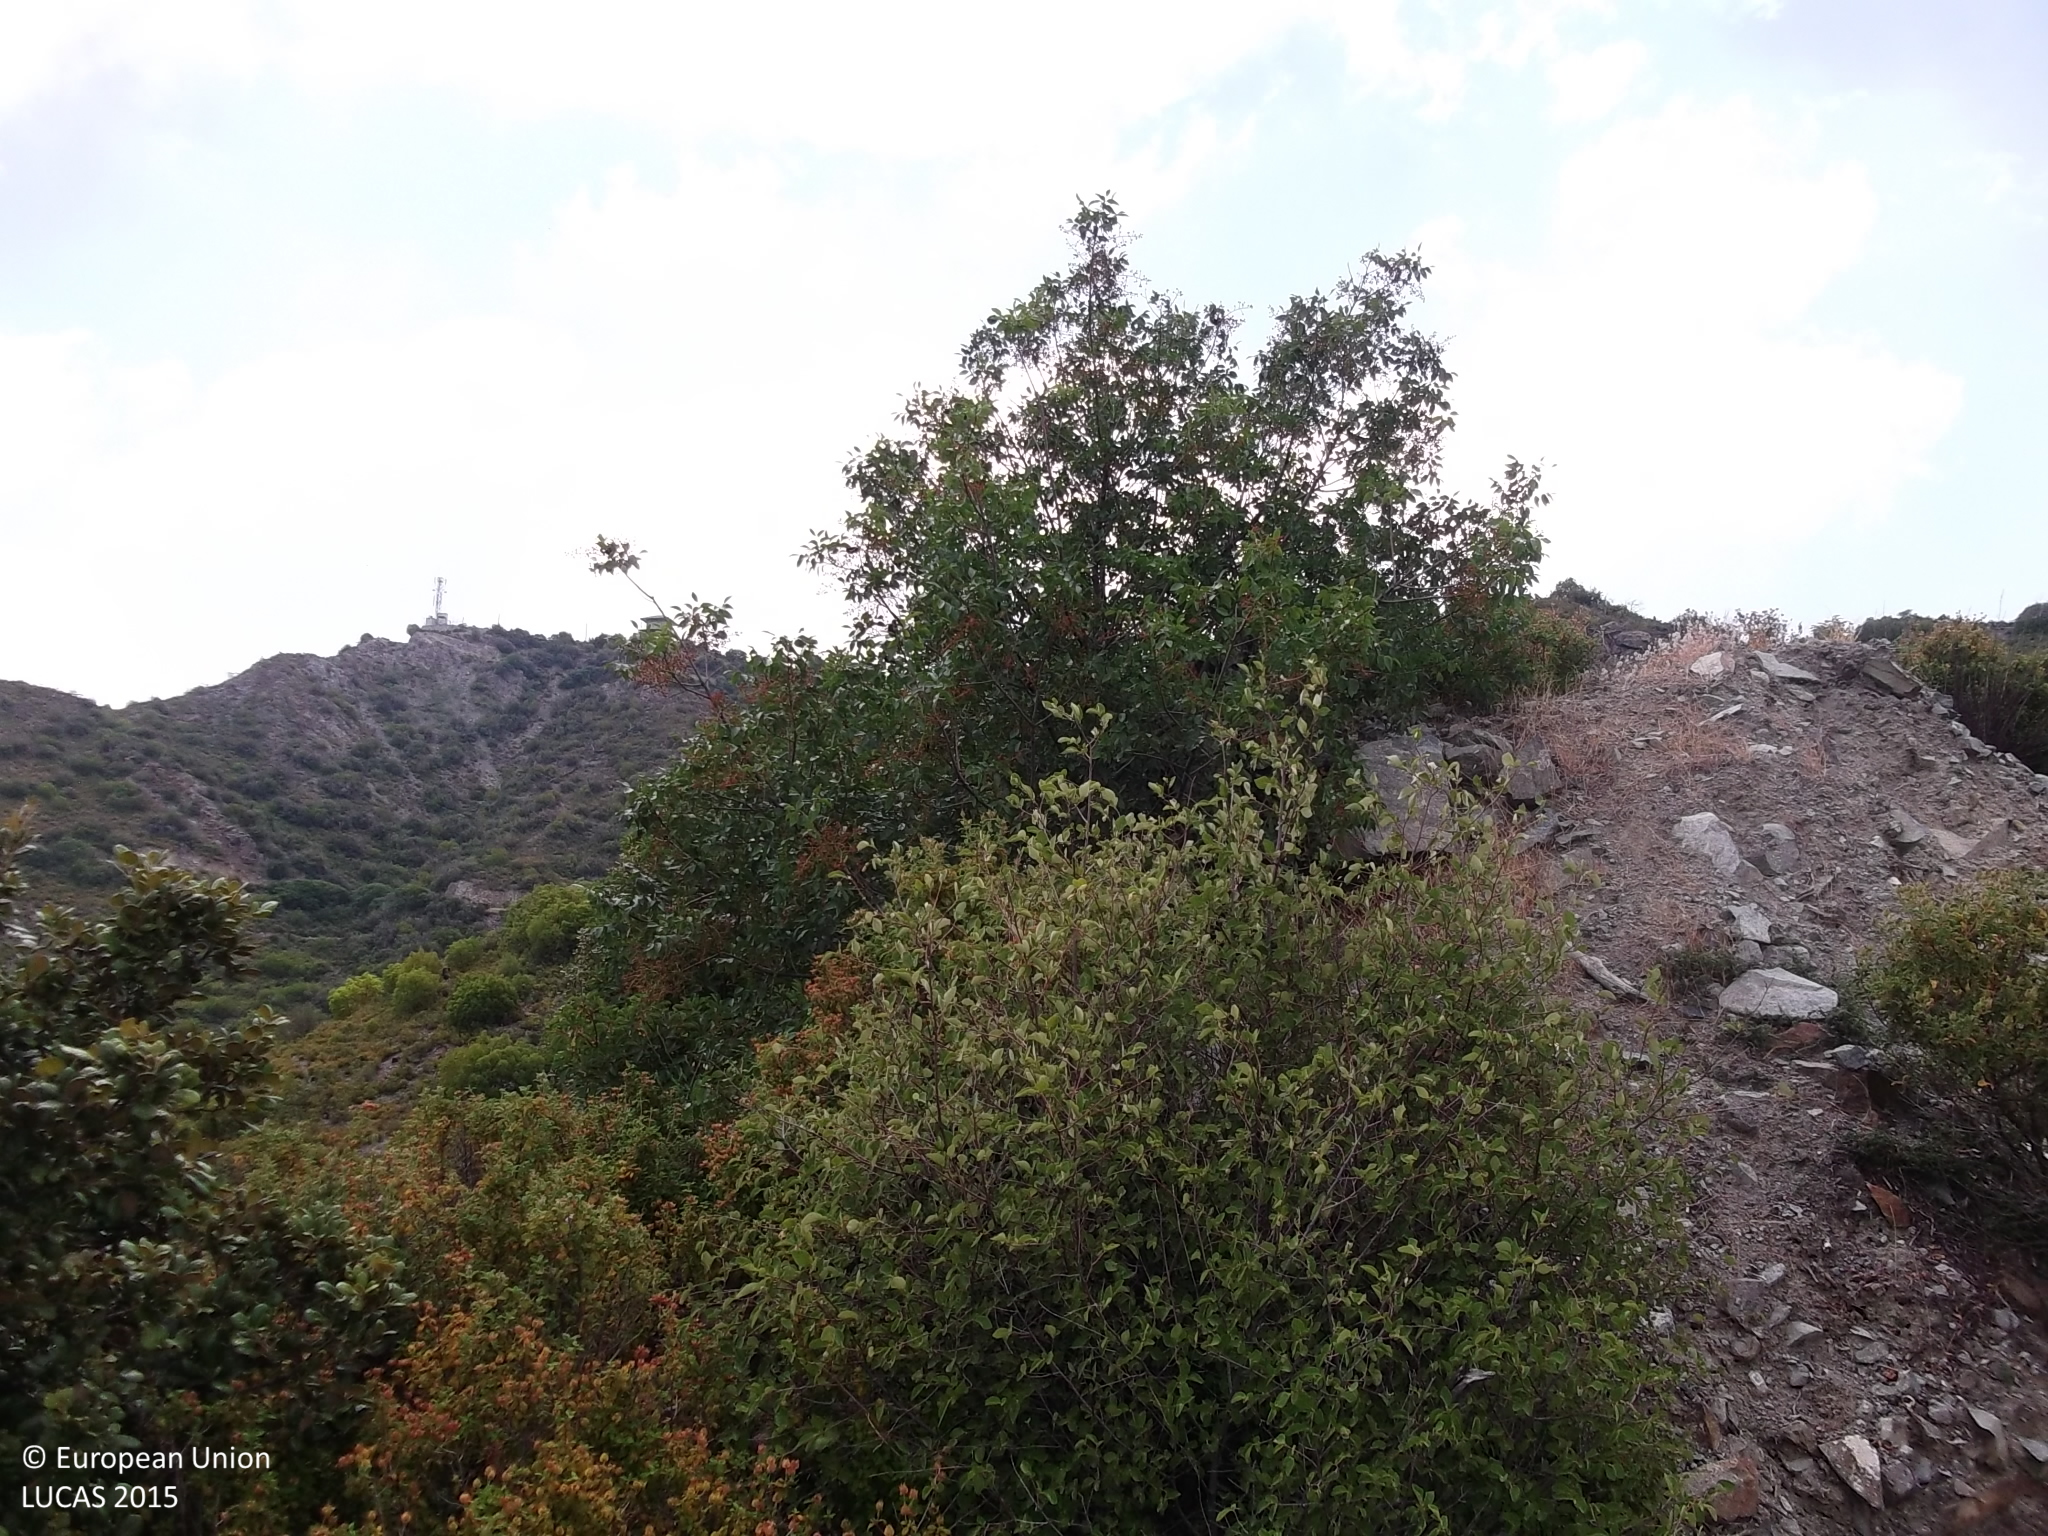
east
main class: Shrubland
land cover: Shrubland with sparse tree cover
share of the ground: > 75 %
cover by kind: shrubs 80 %, consolidated bare surface 10 %, broadleaved forest trees 5 %, unconsolidated bare surface 5 %
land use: Semi-natural and natural areas not in use
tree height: < 5 m
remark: Burnt area
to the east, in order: Shrubland with sparse tree cover; Tracks
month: June
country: CY
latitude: 34.8851
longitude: 32.9368
